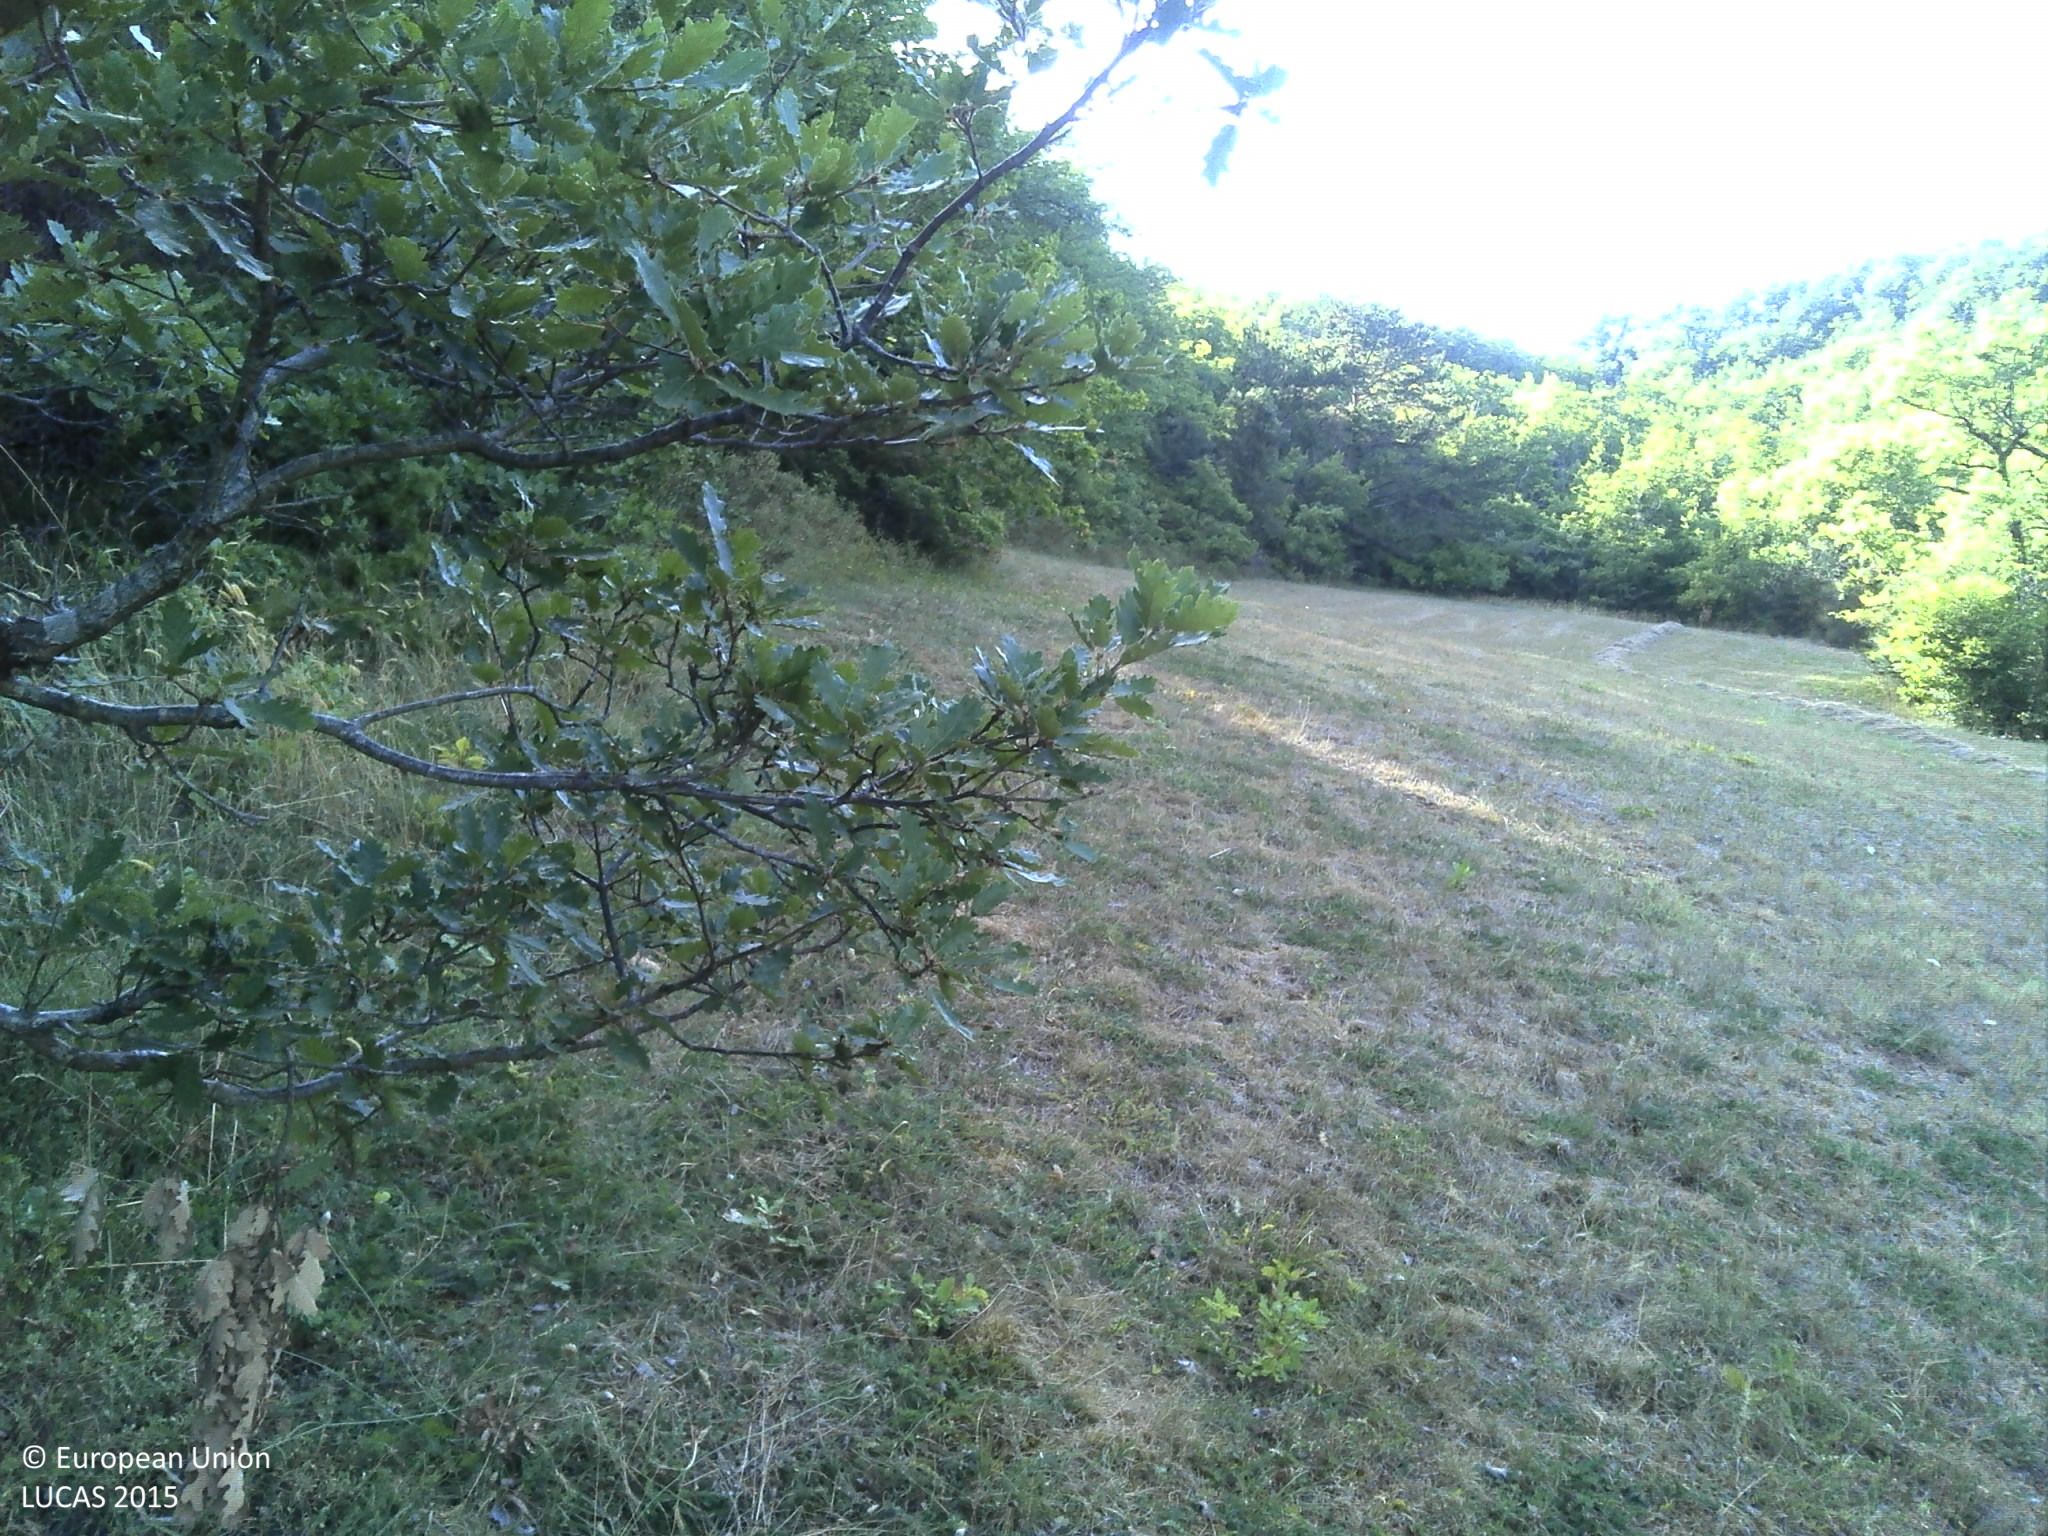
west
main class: Woodland
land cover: Broadleaved woodland
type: acidophilous oak and oak-birch forest
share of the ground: > 75 %
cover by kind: broadleaved forest trees 85 %, herbaceous plants 5 %, lichens and mosses 5 %, unconsolidated bare surface 5 %
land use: Semi-natural and natural areas not in use
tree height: > 5 m
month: July
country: FR
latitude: 43.7614
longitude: 3.1385
